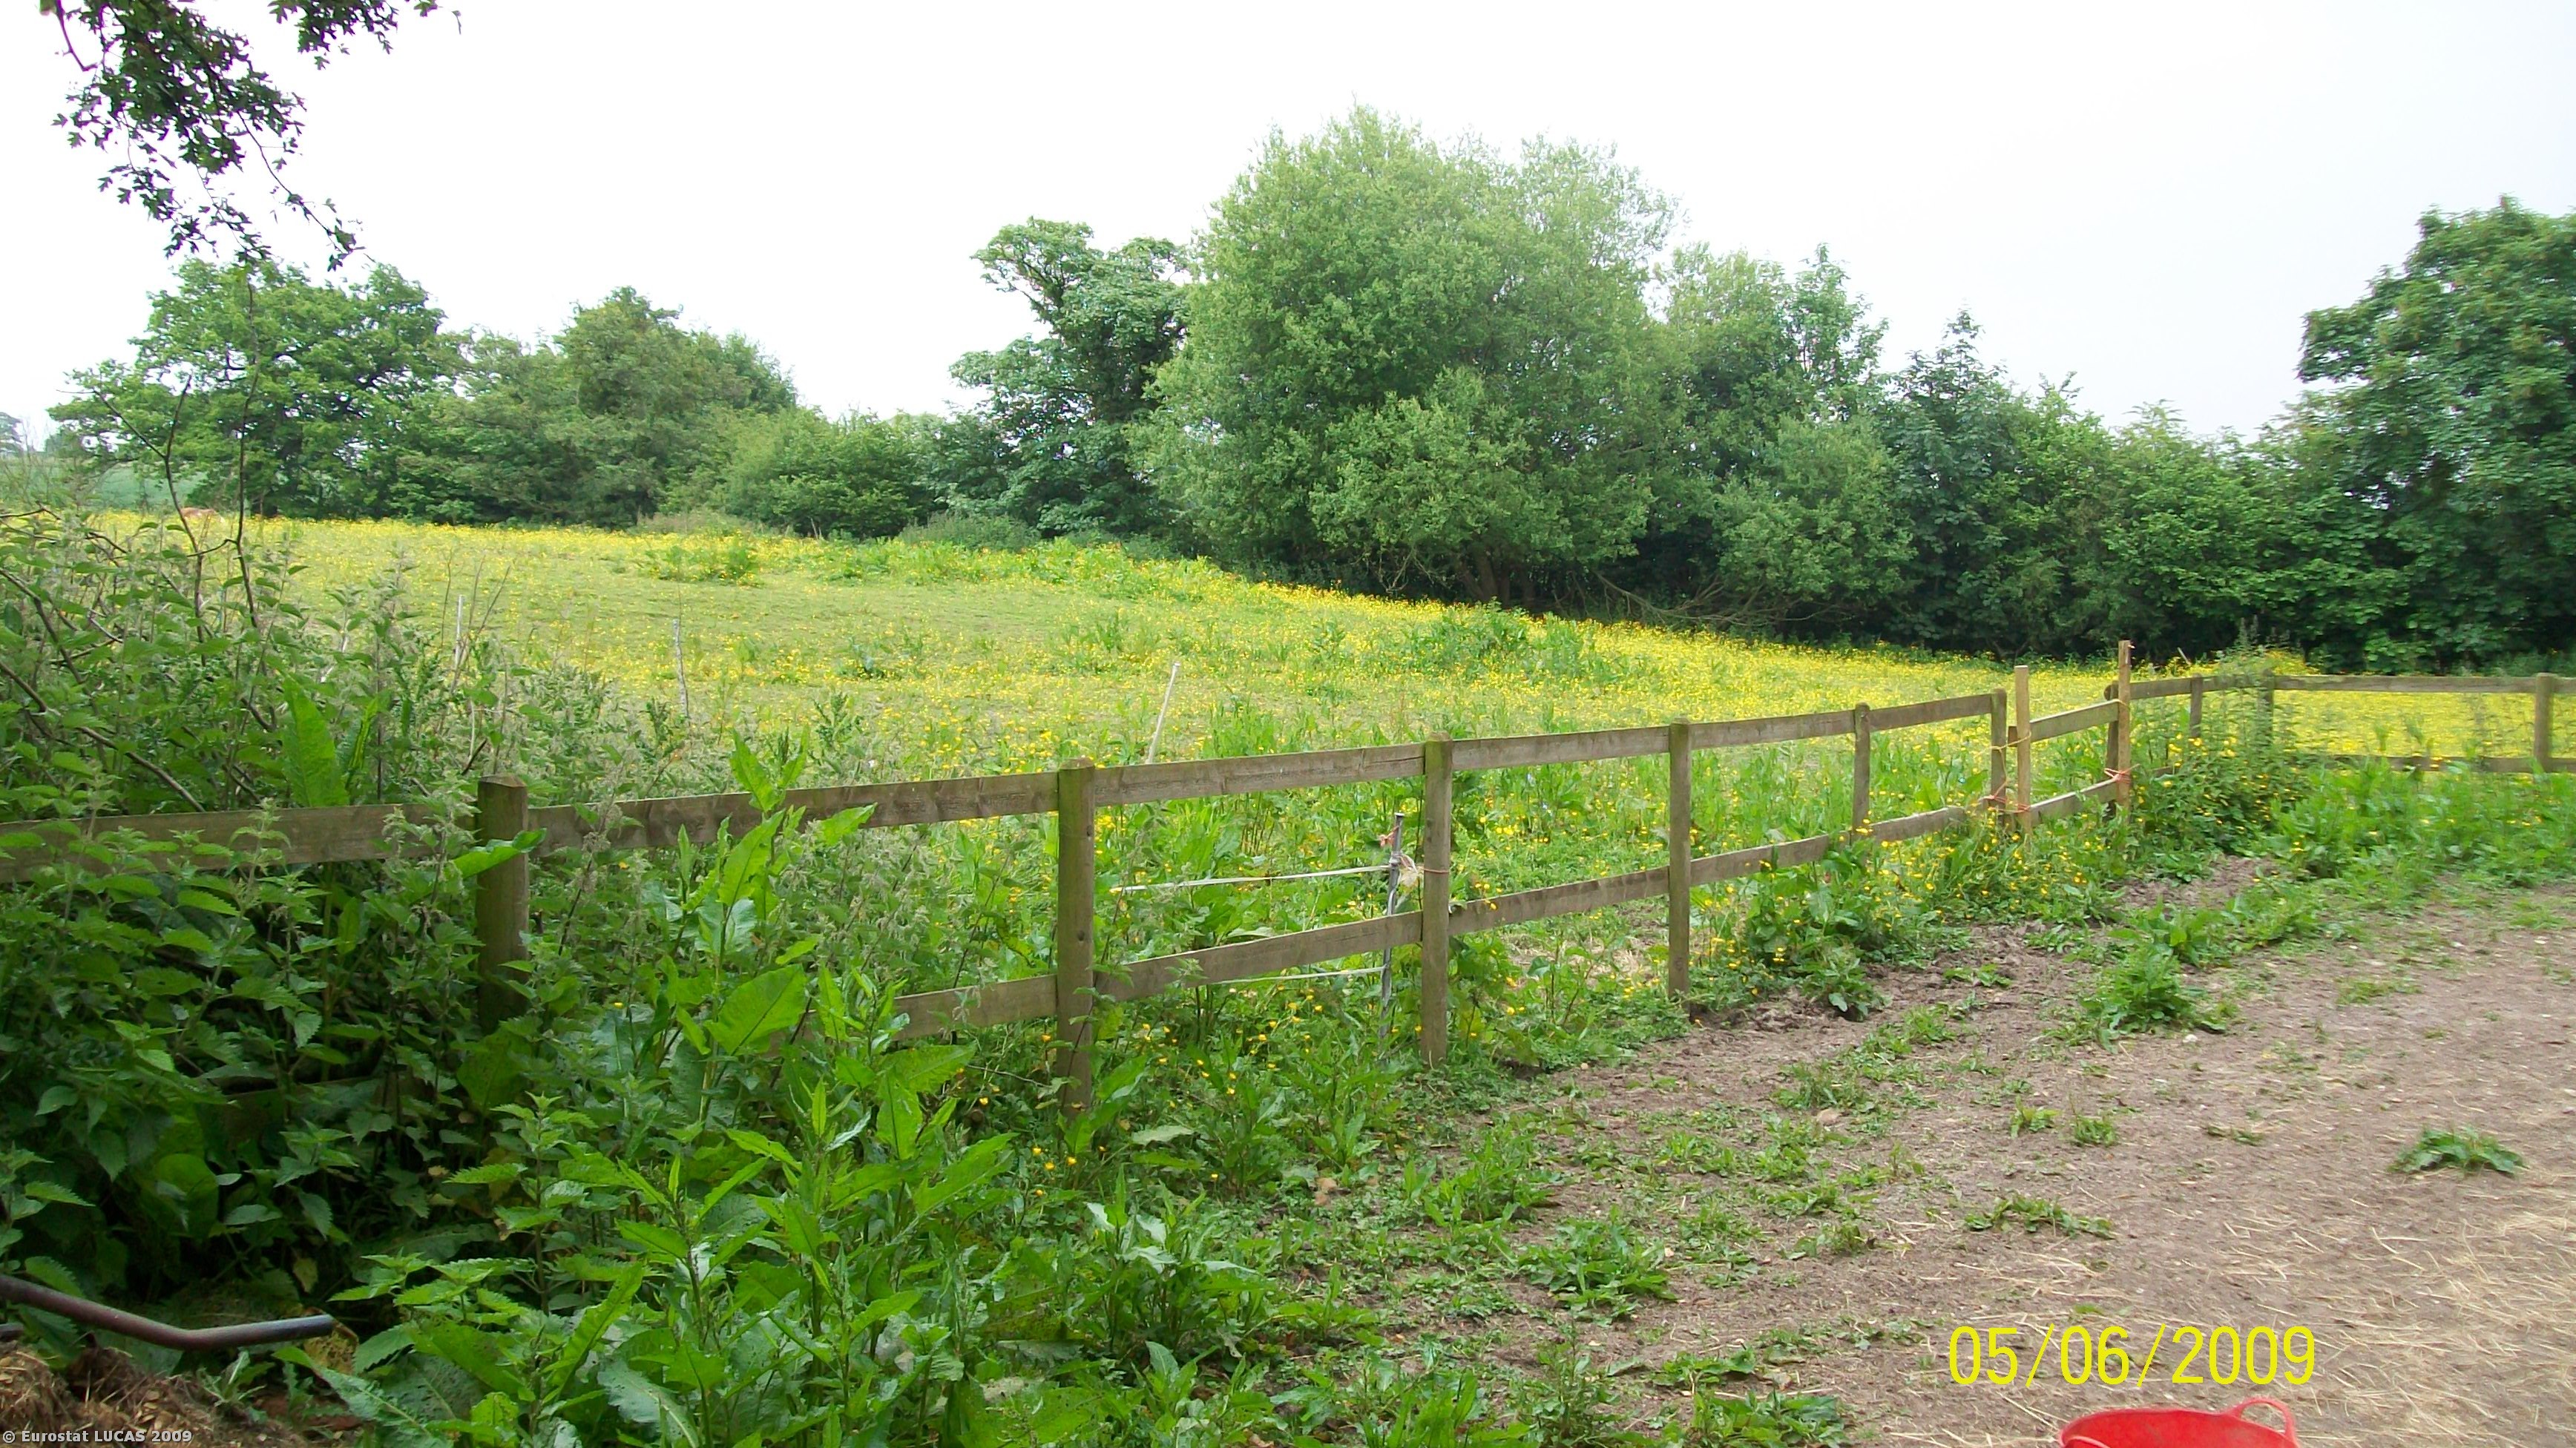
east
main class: Grassland
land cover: Grassland without tree/shrub cover
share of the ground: > 75 %
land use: Fallow land
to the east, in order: Grassland without tree/shrub cover; Managed hedges; Grassland without tree/shrub cover; Managed hedges; Grassland without tree/shrub cover; Managed hedges; Arable land (only in case pi)
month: June
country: GB
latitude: 53.0984
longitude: -2.6584
